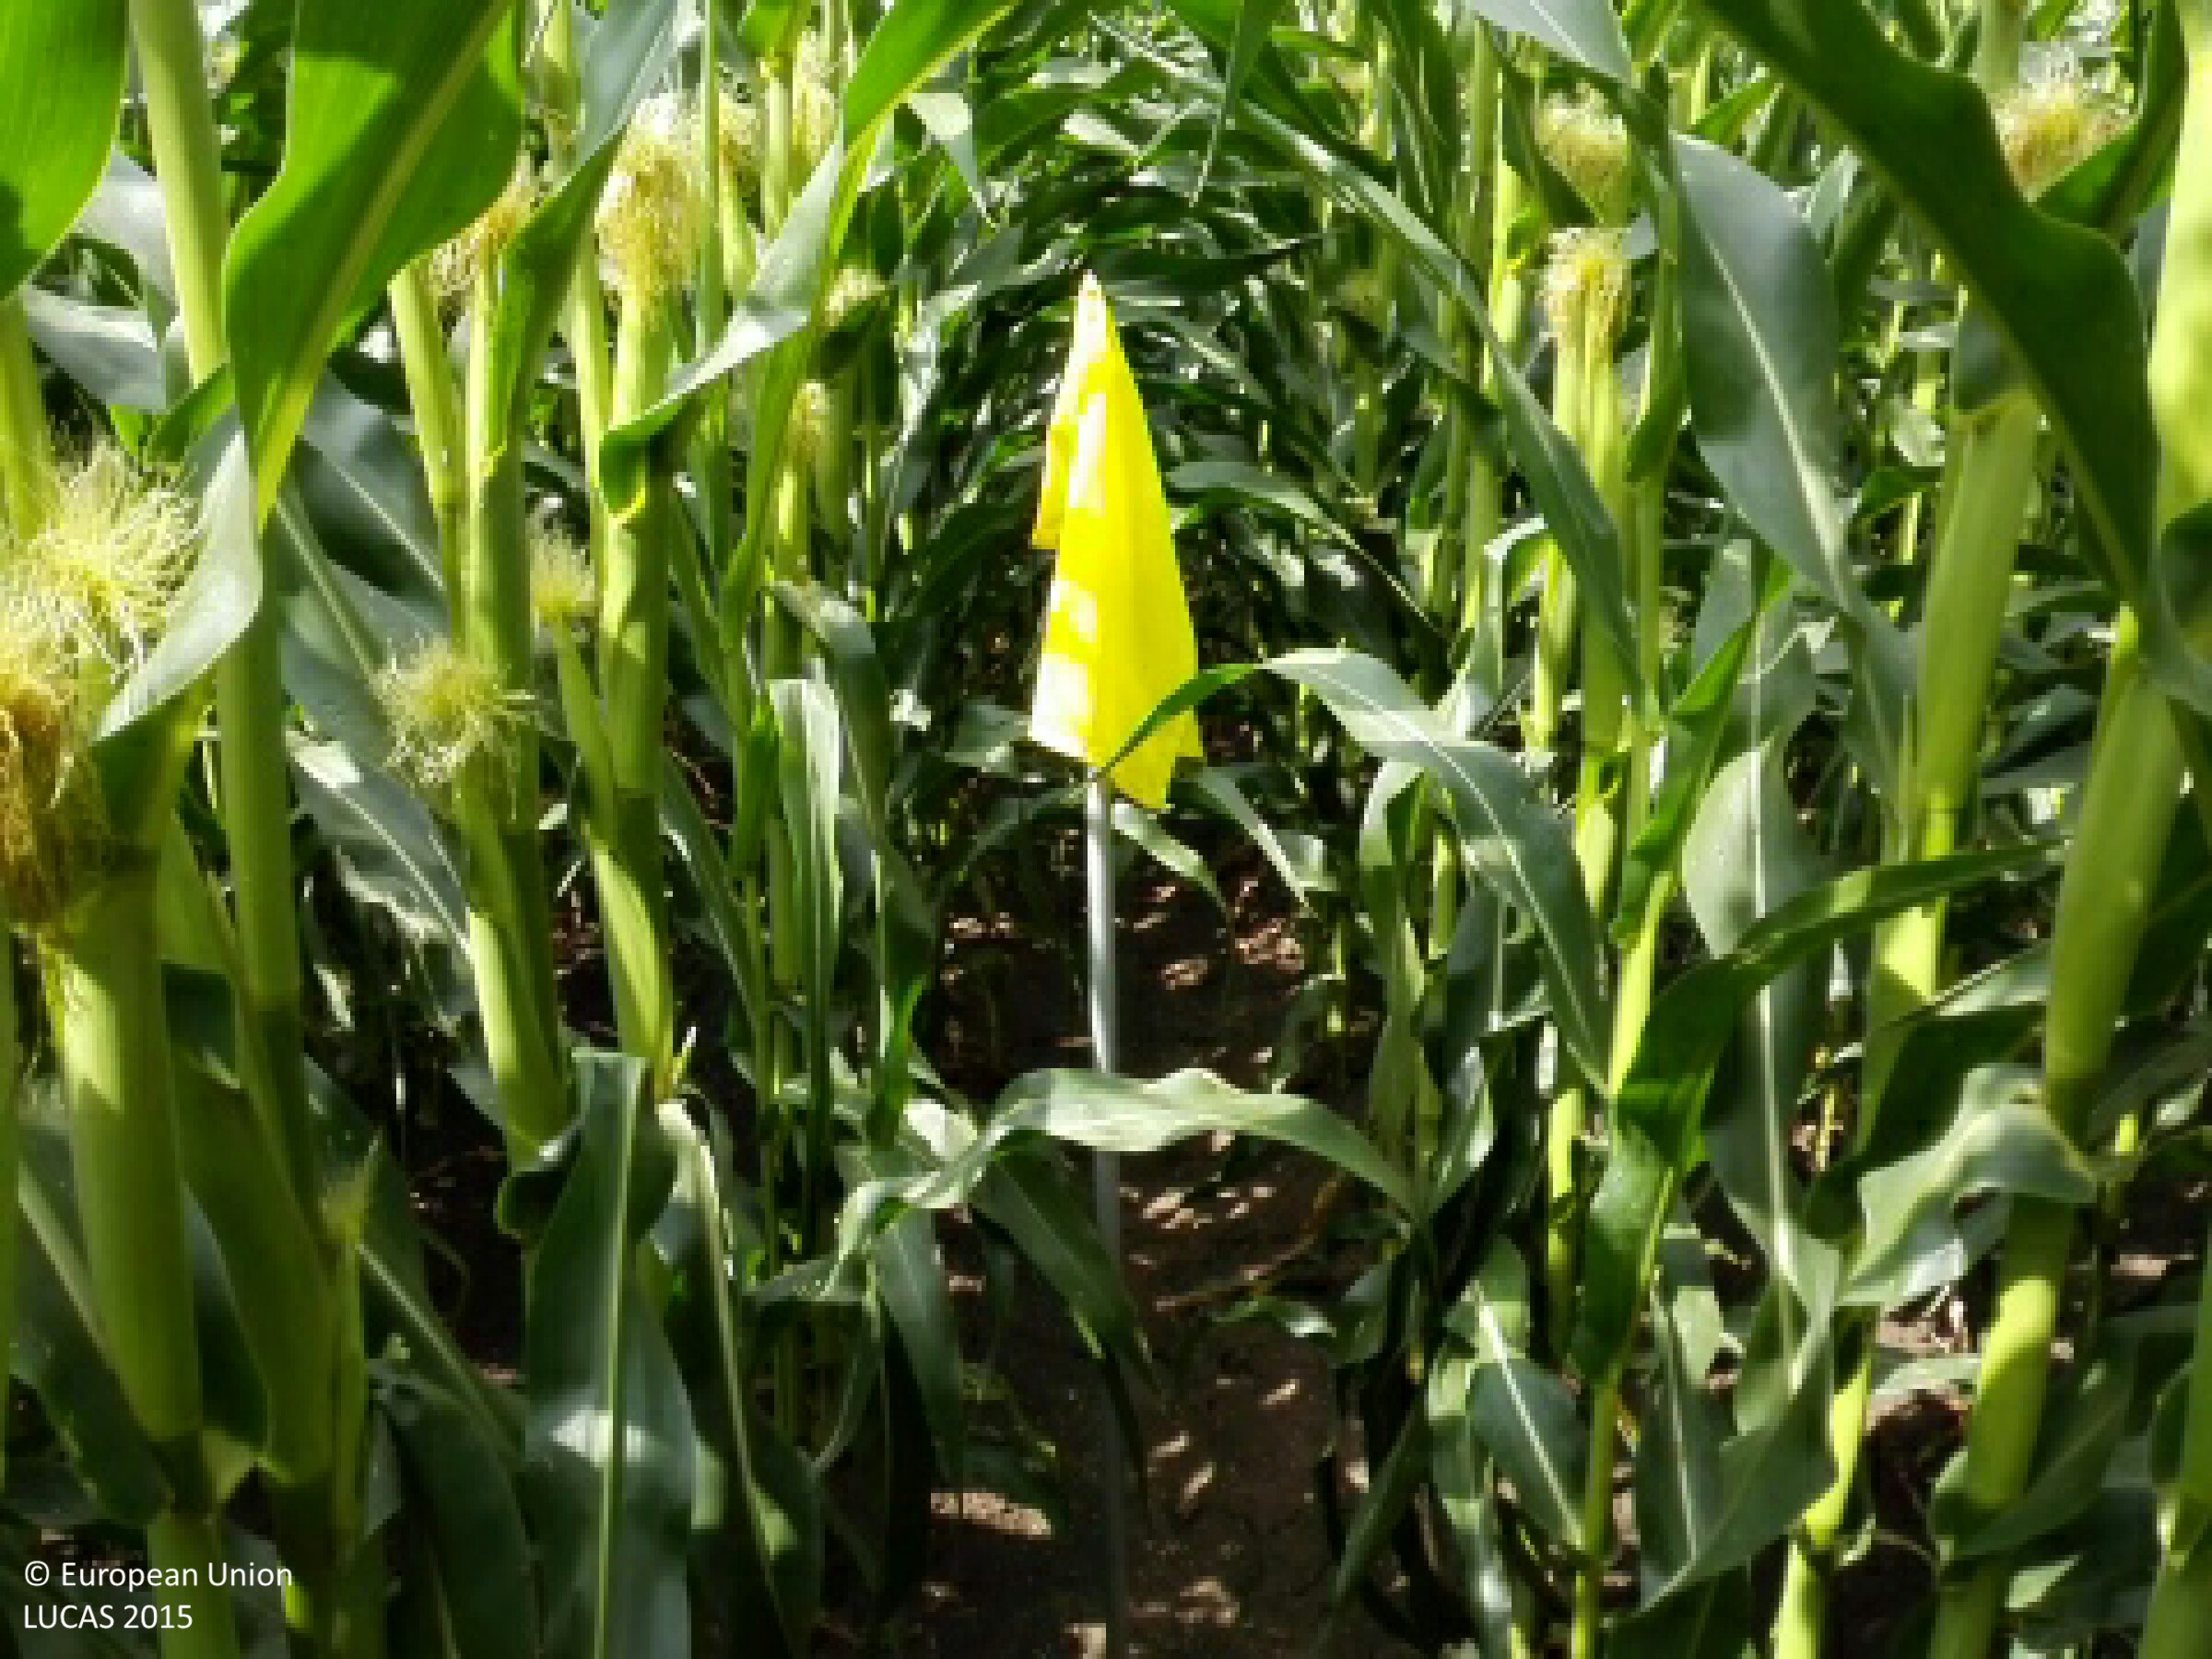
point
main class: Cropland
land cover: Maize
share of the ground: > 75 %
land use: Agriculture (excluding fallow land and kitchen gardens)
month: July
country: HU
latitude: 47.5446
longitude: 21.3479
